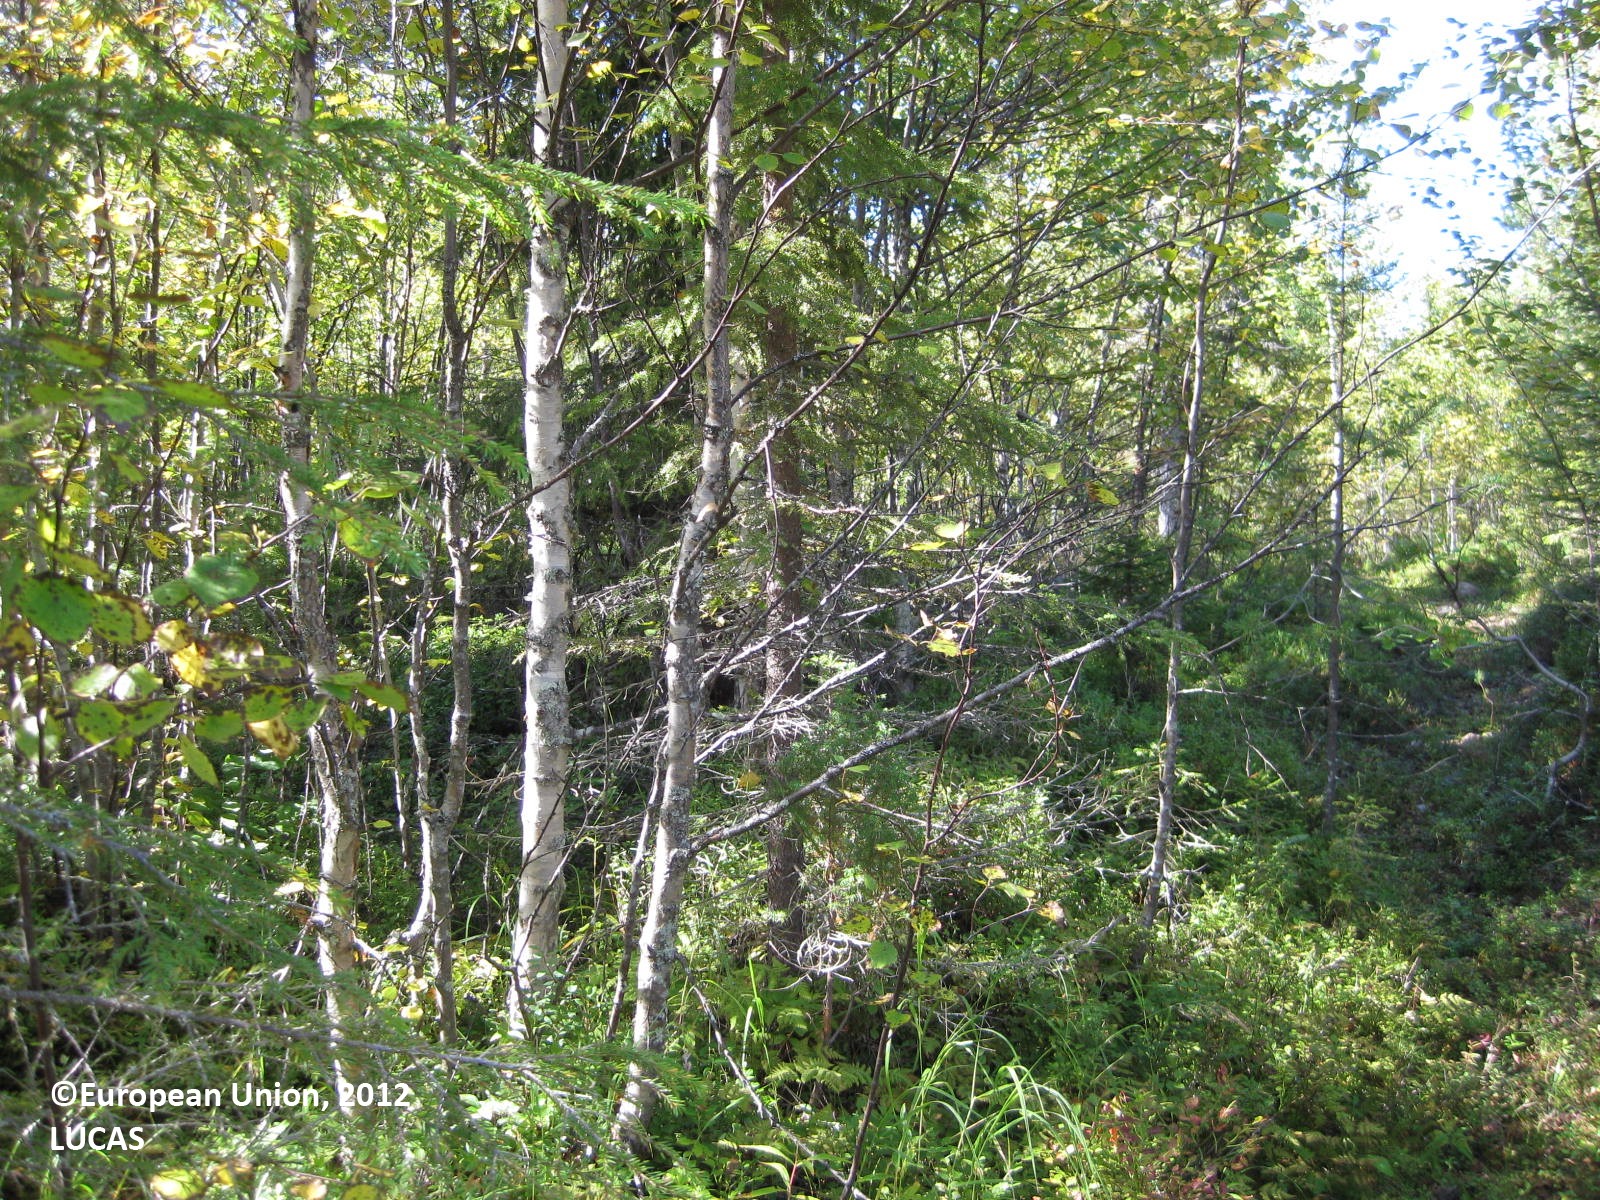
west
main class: Woodland
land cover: Other mixed woodland
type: boreal forest
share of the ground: > 75 %
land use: Forestry
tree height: > 5 m
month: August
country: FI
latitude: 66.0491
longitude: 29.7358
